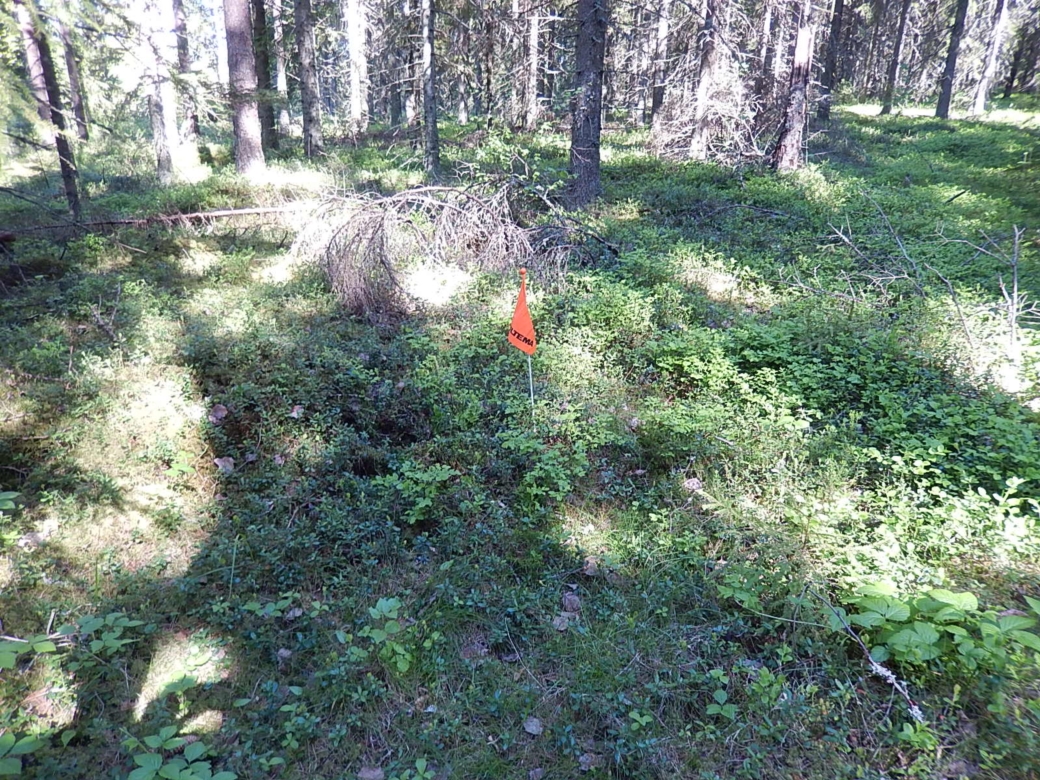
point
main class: Woodland
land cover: Spruce dominated coniferous woodland
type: boreal forest
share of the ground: > 75 %
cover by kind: coniferous forest trees 85 %, shrubs 15 %
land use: Forestry
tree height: > 5 m
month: June
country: FI
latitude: 62.0396
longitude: 21.5374
